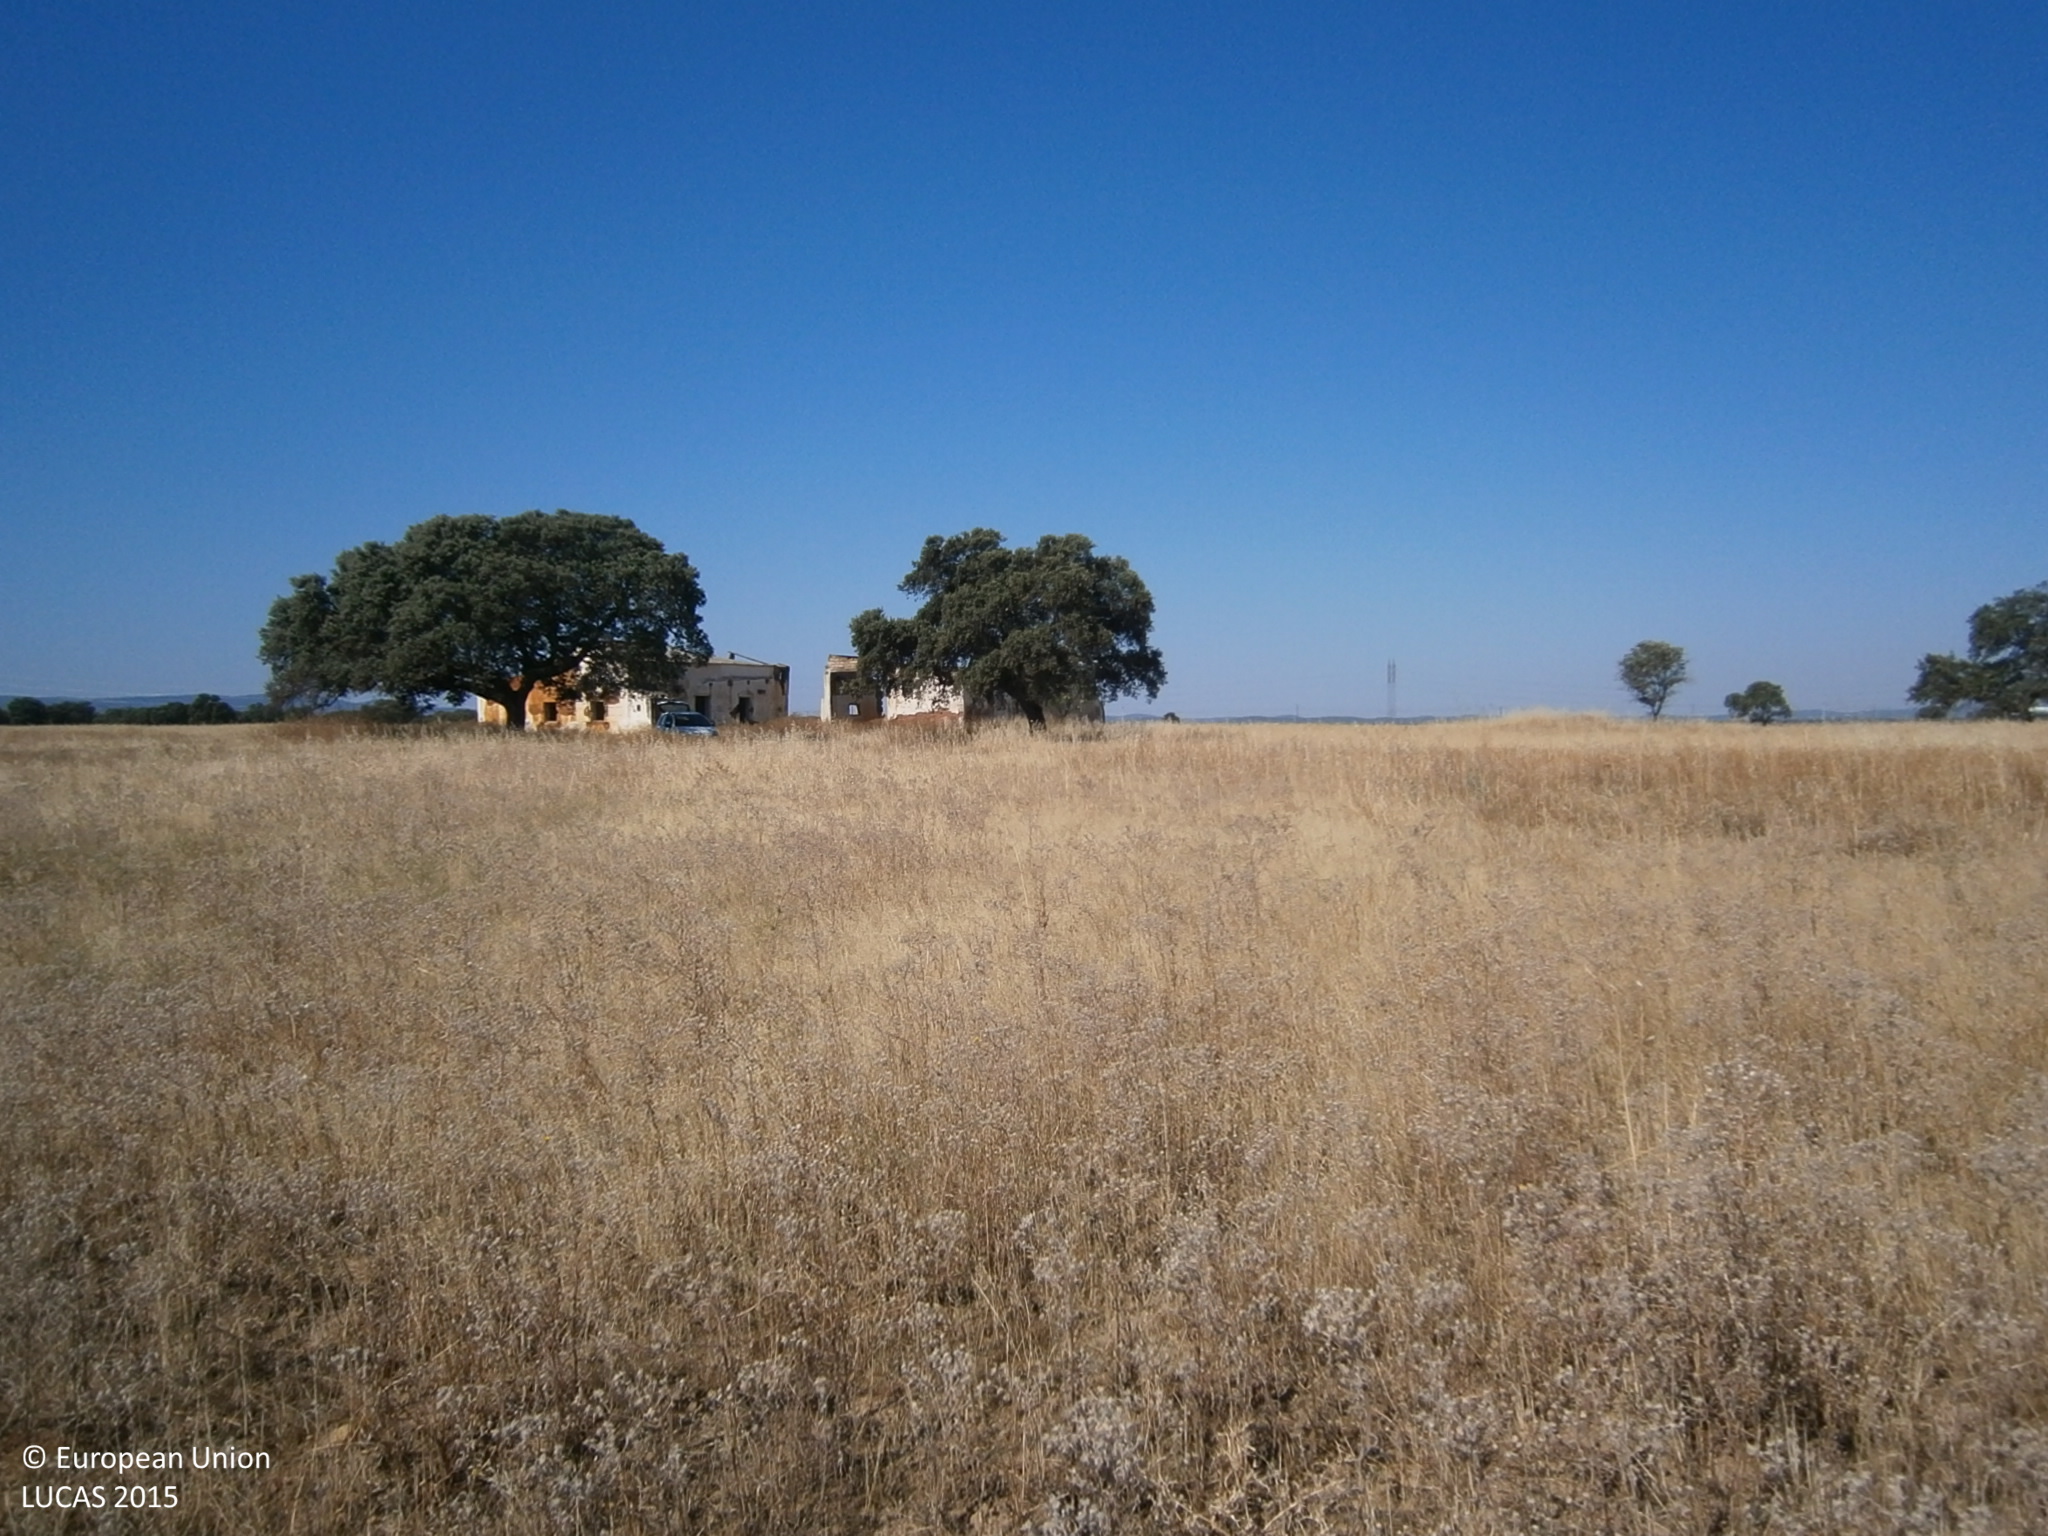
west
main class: Grassland
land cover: Spontaneously vegetated surfaces
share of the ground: > 75 %
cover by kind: herbaceous plants 95 %, unconsolidated bare surface 5 %
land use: Fallow land
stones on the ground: 10 - 25 %
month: June
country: ES
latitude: 38.6840
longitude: -6.7652
